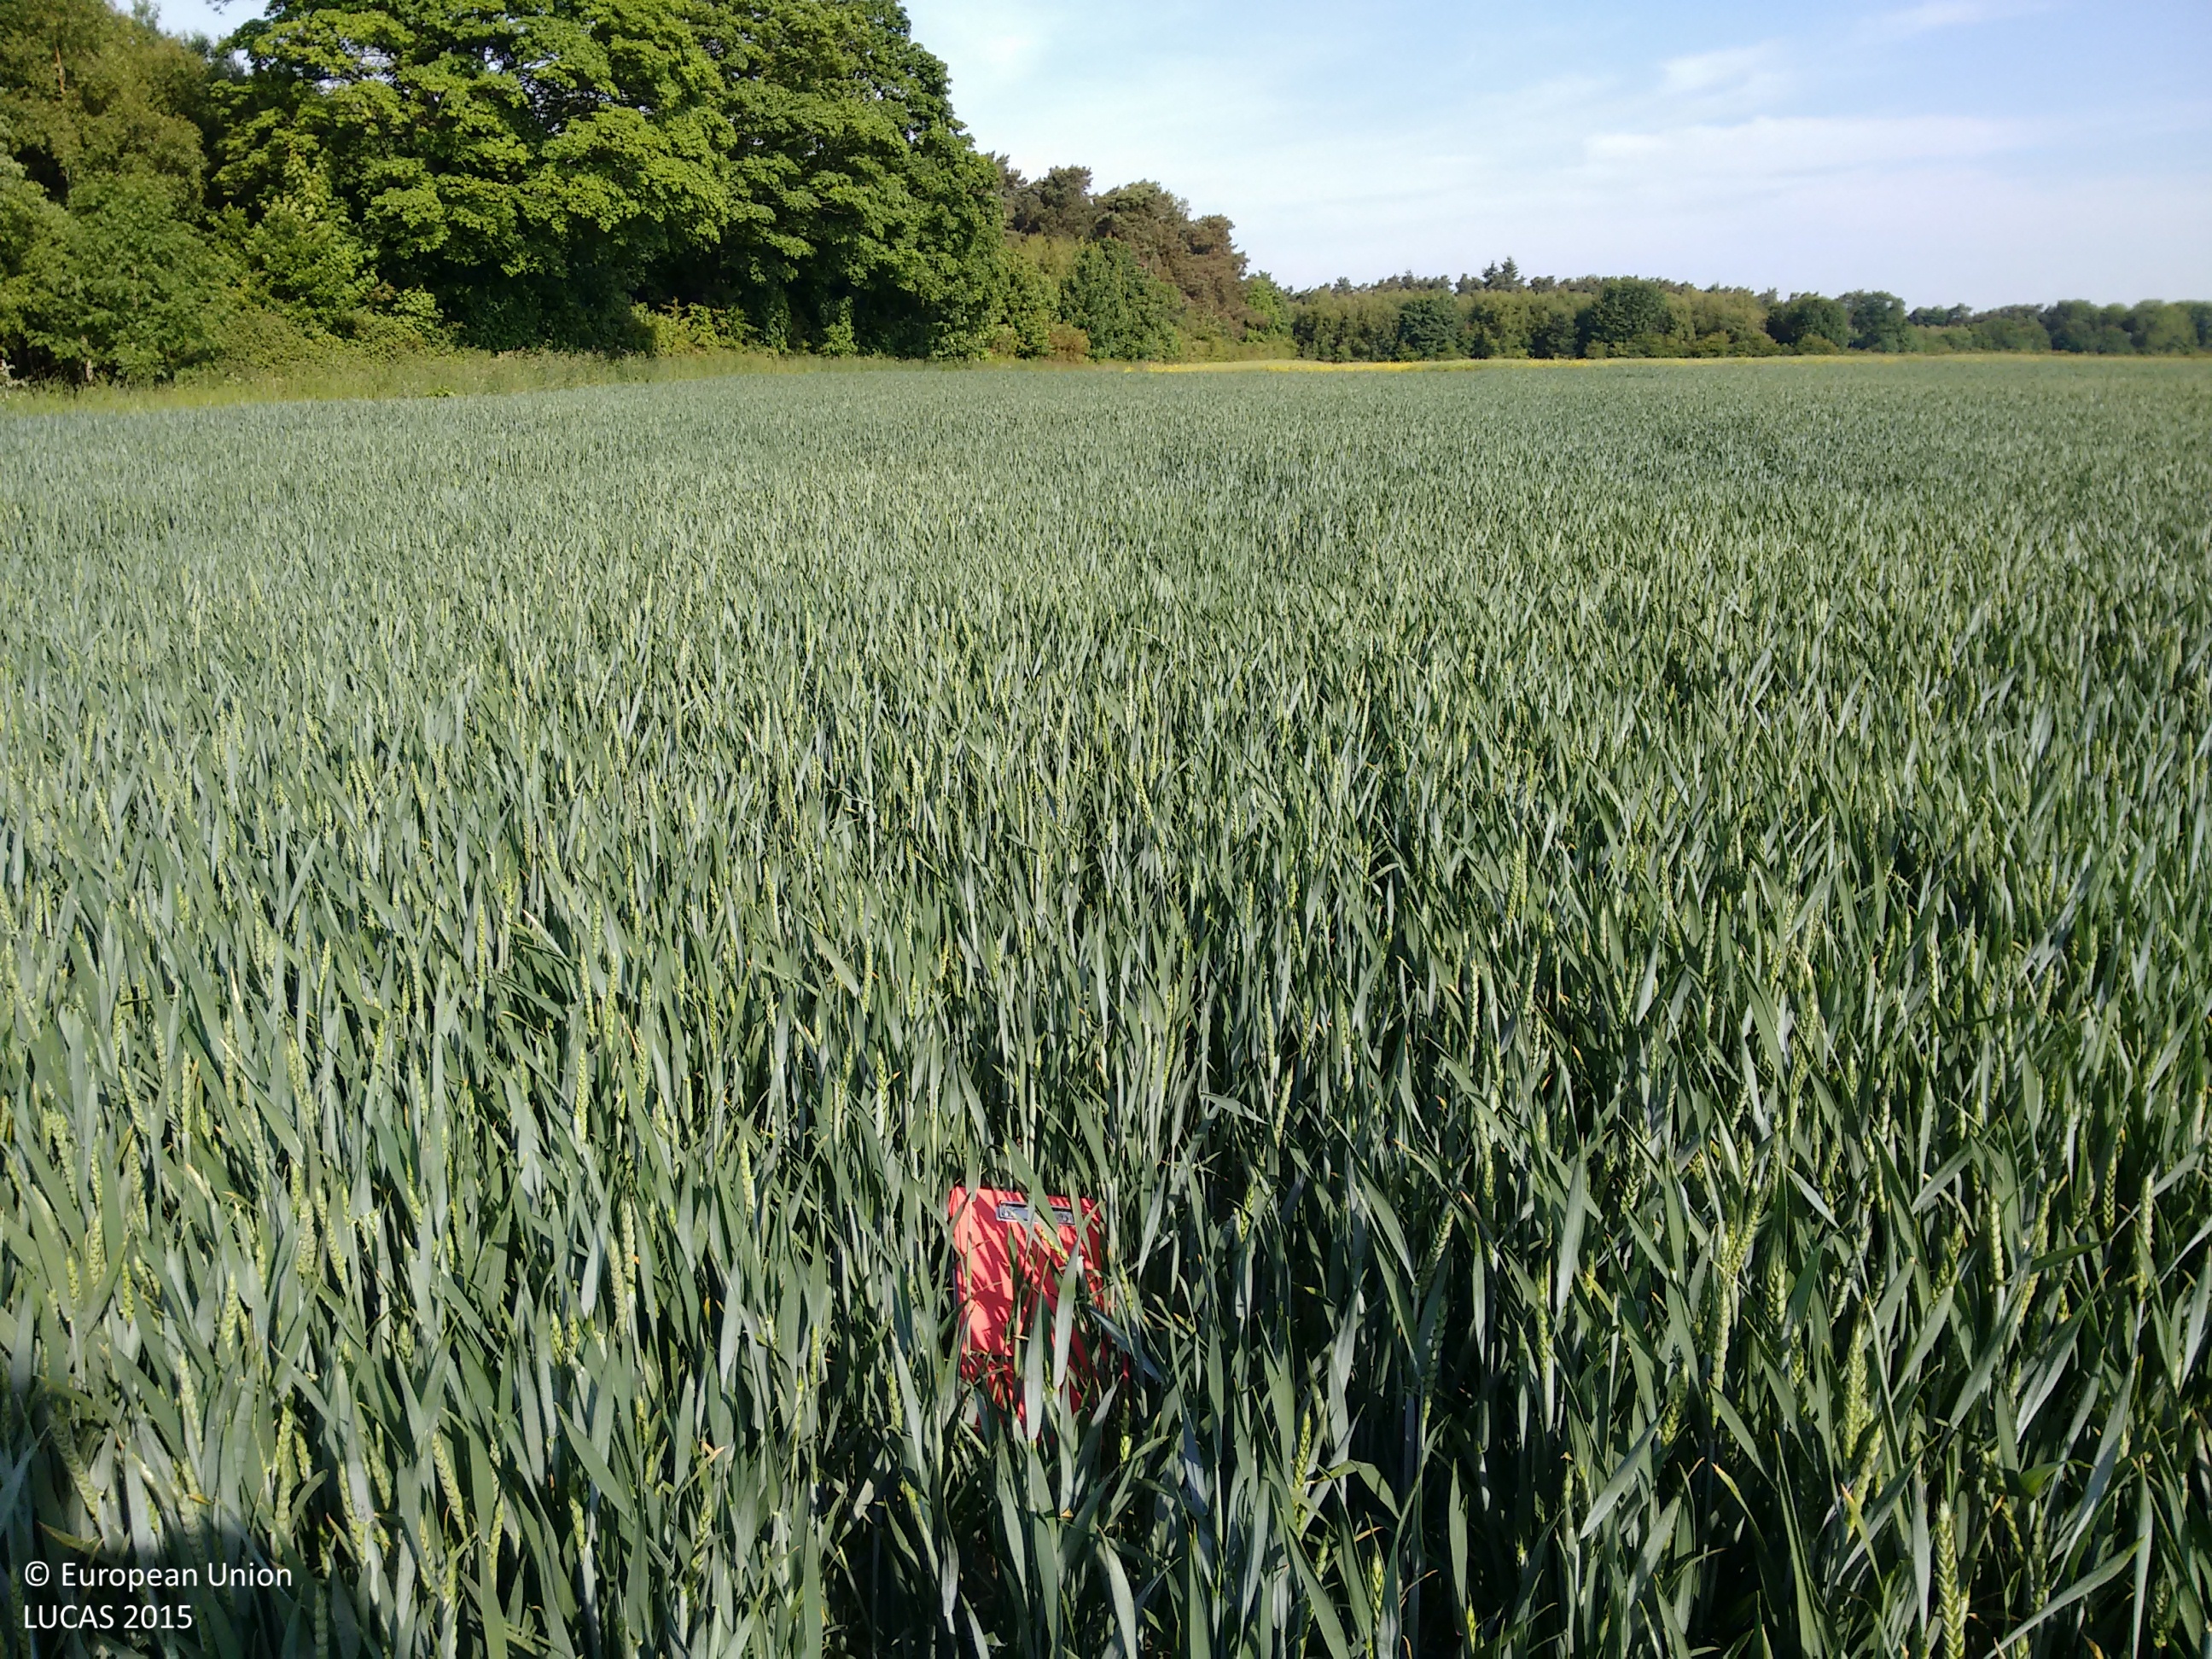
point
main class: Cropland
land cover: Common wheat
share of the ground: > 75 %
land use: Agriculture (excluding fallow land and kitchen gardens)
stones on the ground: < 10 %
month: June
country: GB
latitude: 53.7938
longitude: -1.1419
